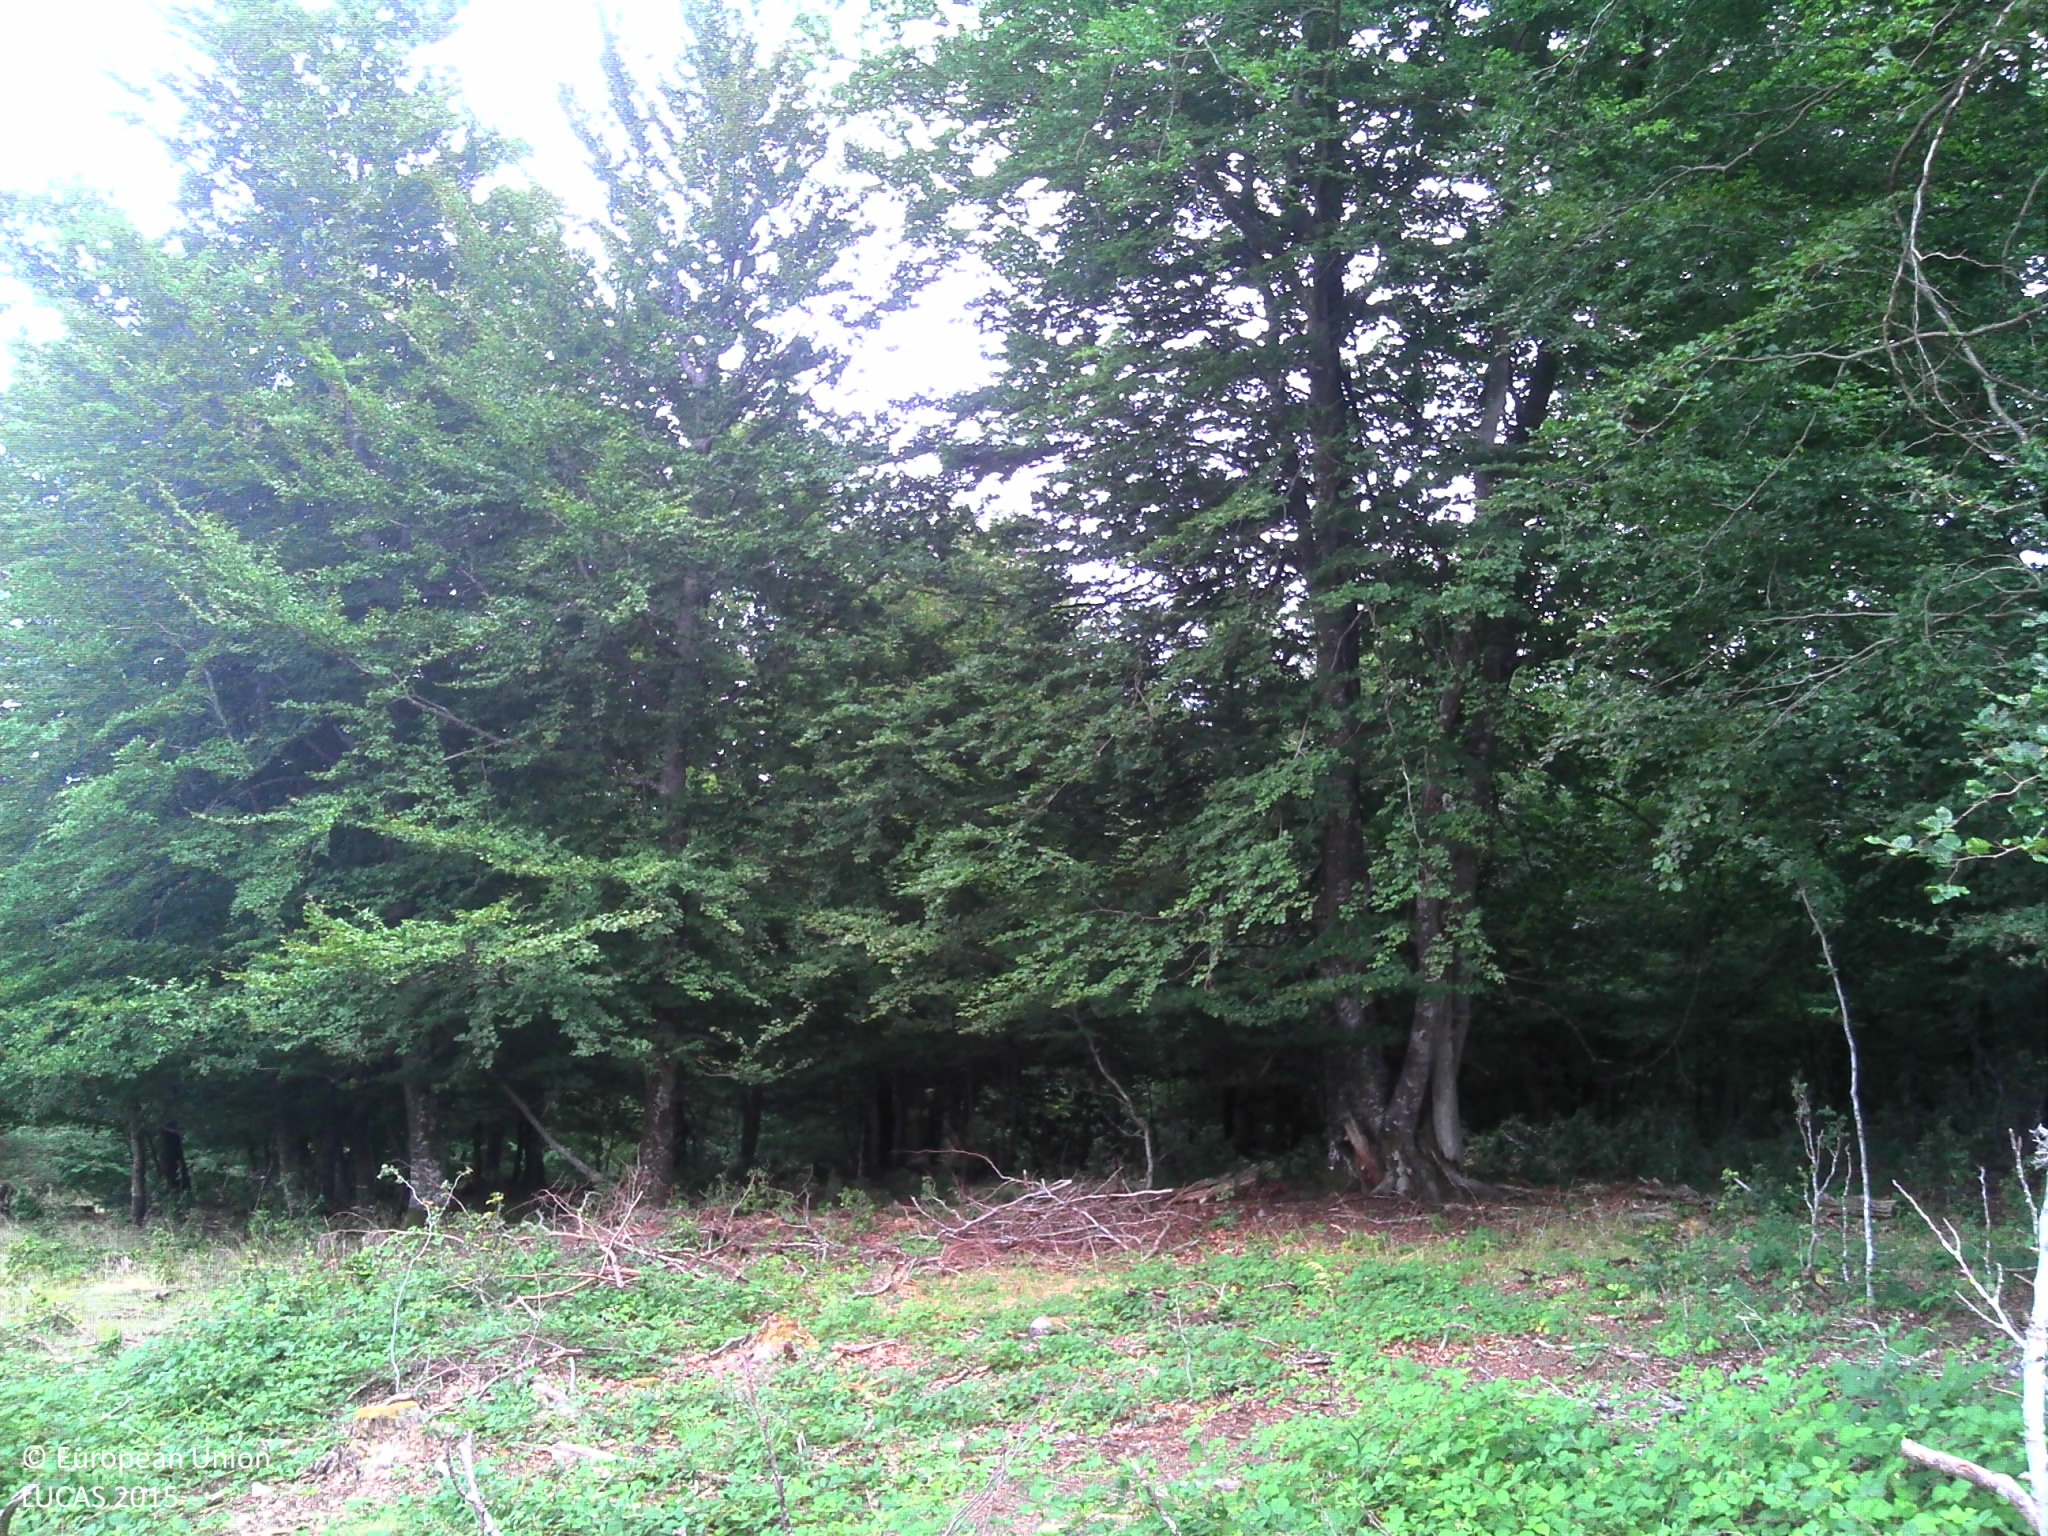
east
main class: Grassland
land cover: Grassland with sparse tree/shrub cover
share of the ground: > 75 %
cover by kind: herbaceous plants 85 %, shrubs 10 %, broadleaved forest trees 5 %
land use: Agriculture (excluding fallow land and kitchen gardens)
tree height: < 5 m
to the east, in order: Grassland with sparse tree/shrub cover; Broadleaved woodland; Tracks; Broadleaved woodland; Pine dominated mixed woodland; Shrubland with sparse tree cover; Broadleaved woodland; Rivers and streams; Broadleaved woodland
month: July
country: FR
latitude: 44.8842
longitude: 3.1537
